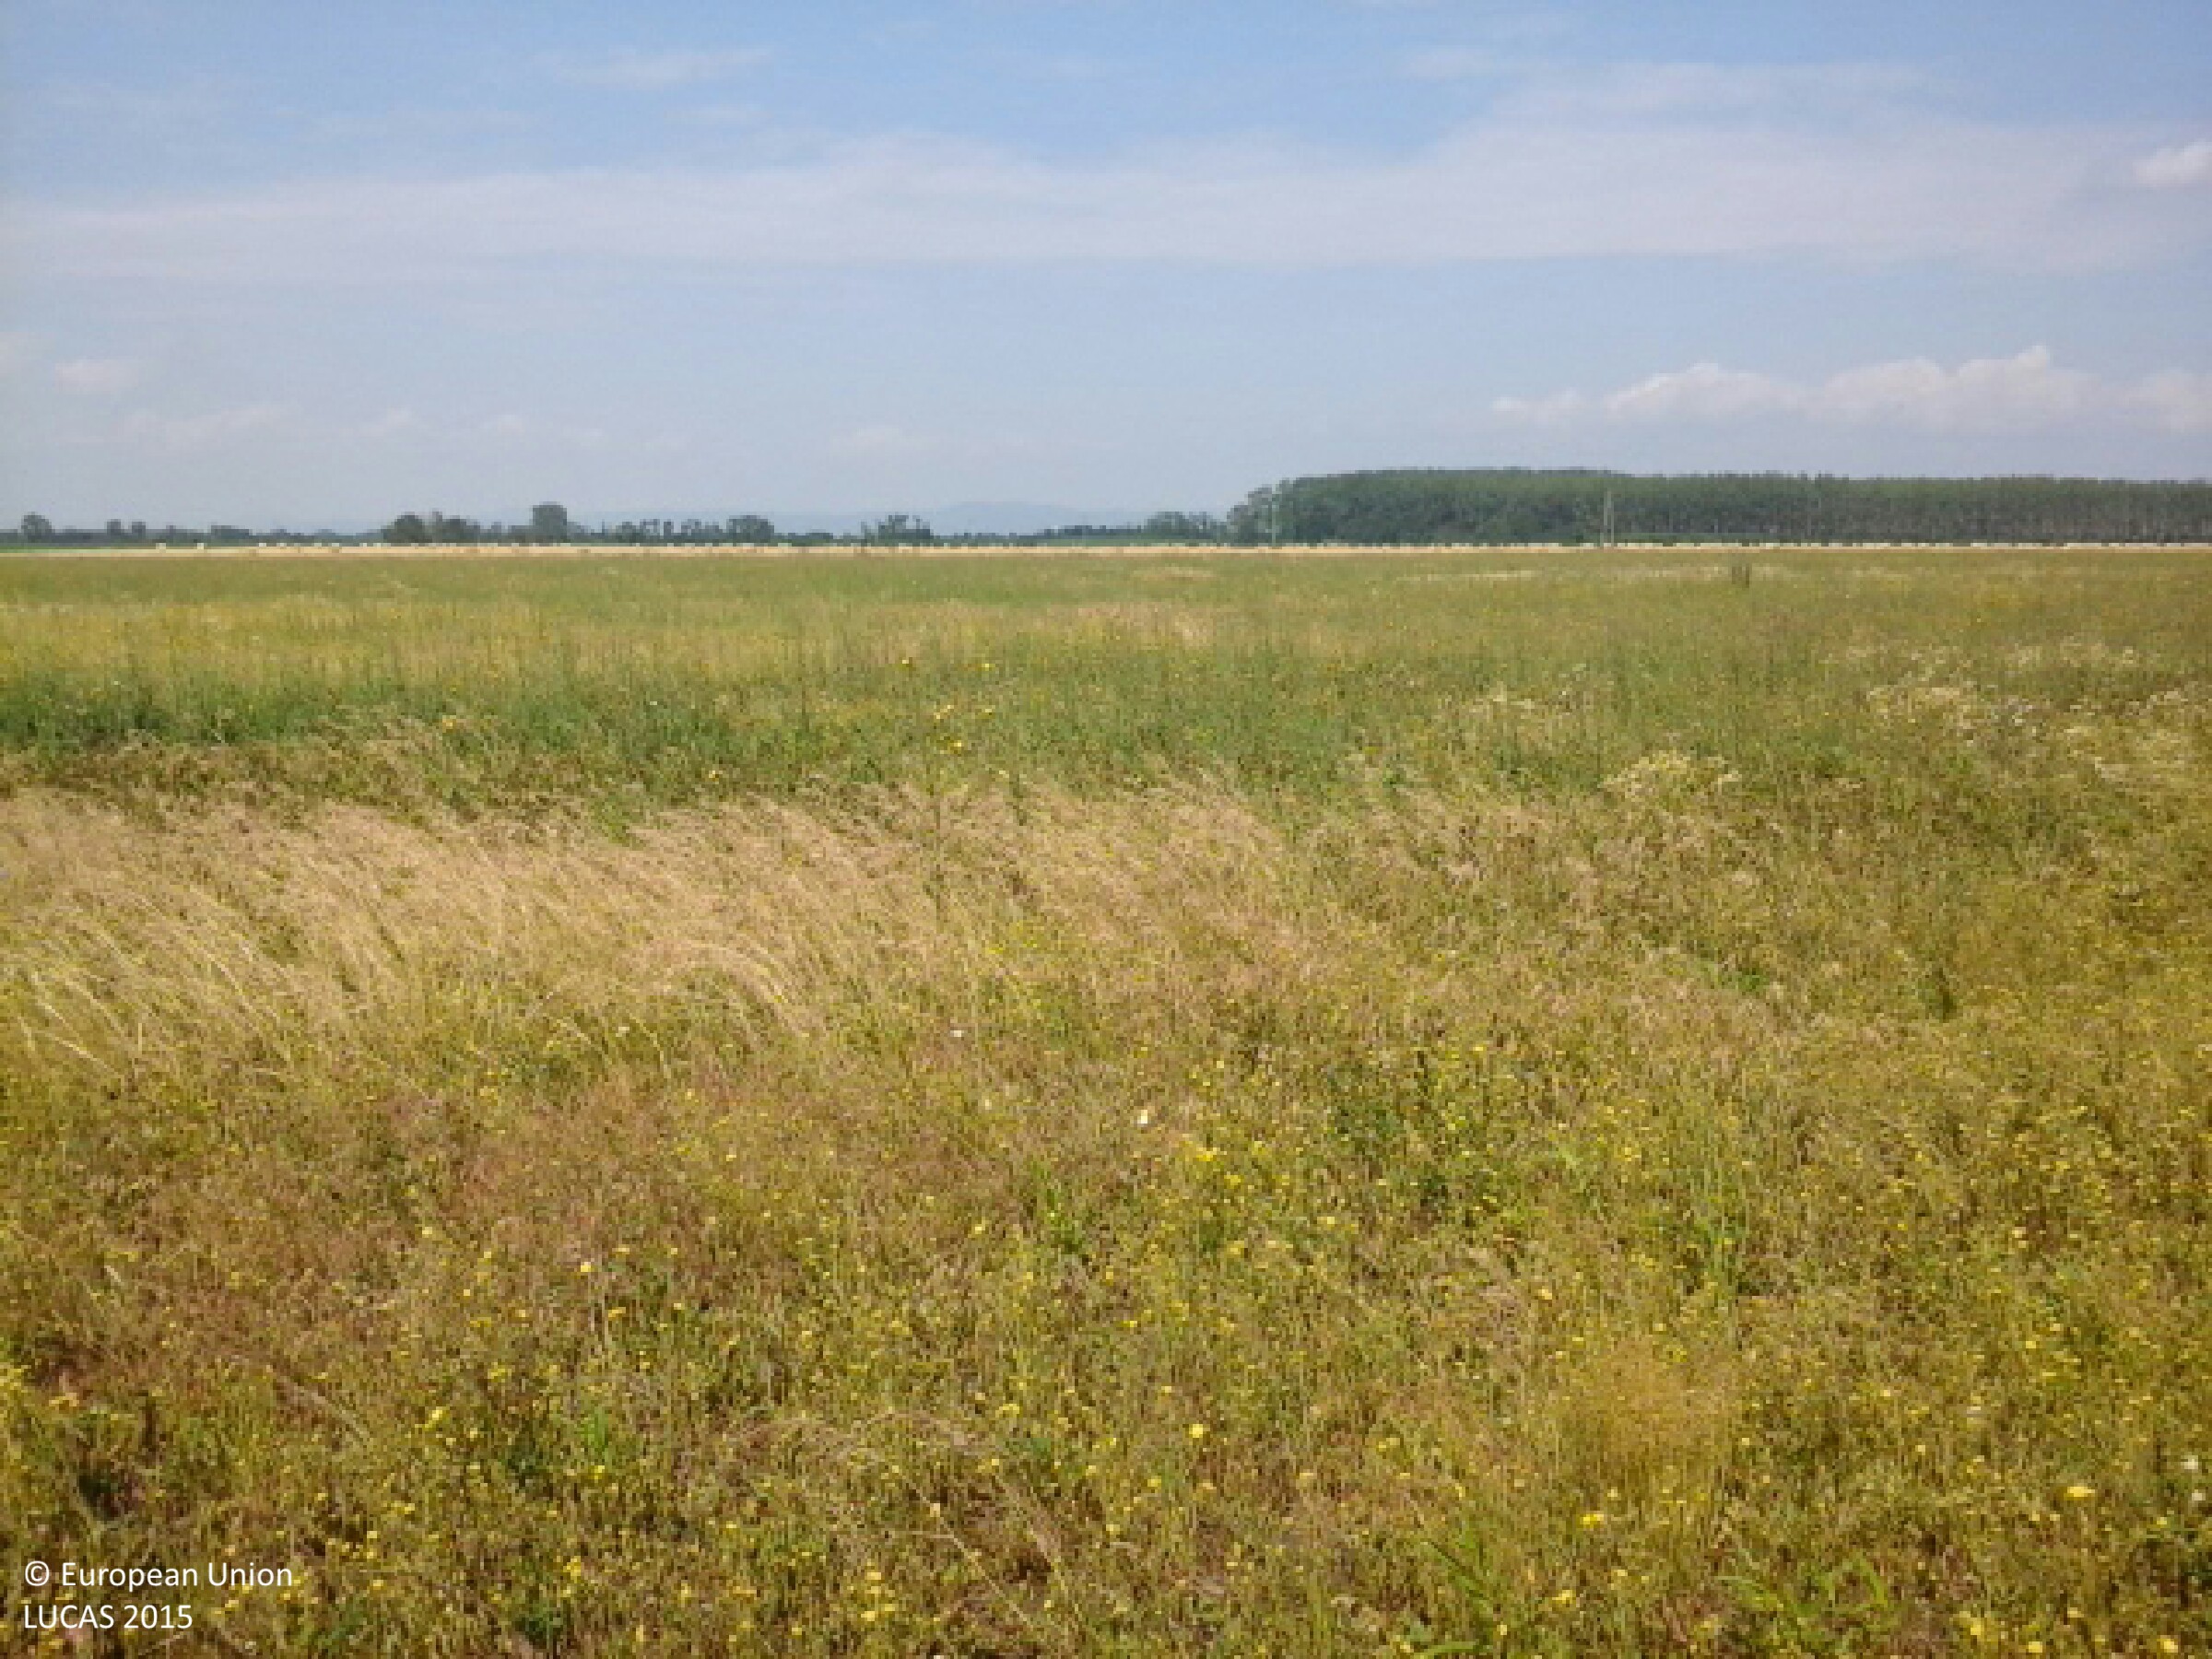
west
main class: Grassland
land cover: Grassland without tree/shrub cover
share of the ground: > 75 %
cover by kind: herbaceous plants 100 %
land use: Semi-natural and natural areas not in use
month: June
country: HU
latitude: 48.3179
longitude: 21.7690
